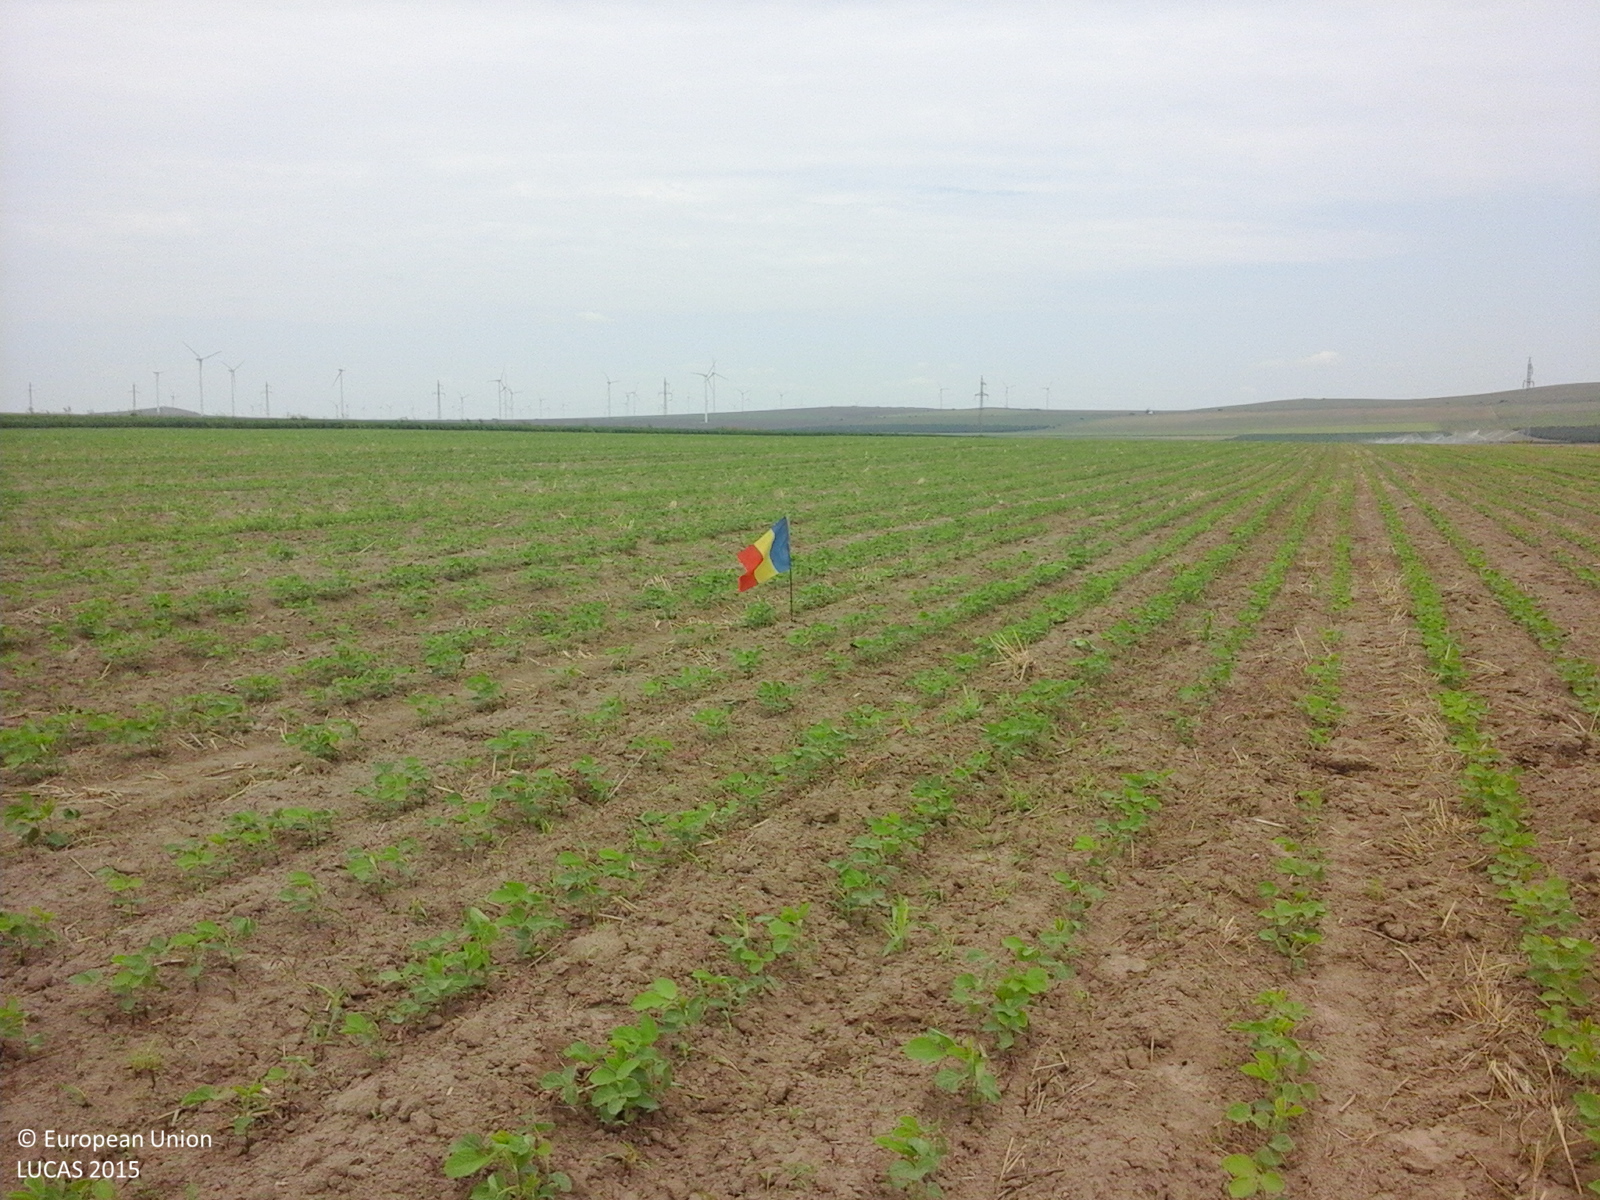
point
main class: Cropland
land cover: Soya
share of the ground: 10 - 25 %
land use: Agriculture (excluding fallow land and kitchen gardens)
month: August
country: RO
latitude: 45.0349
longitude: 28.9961
